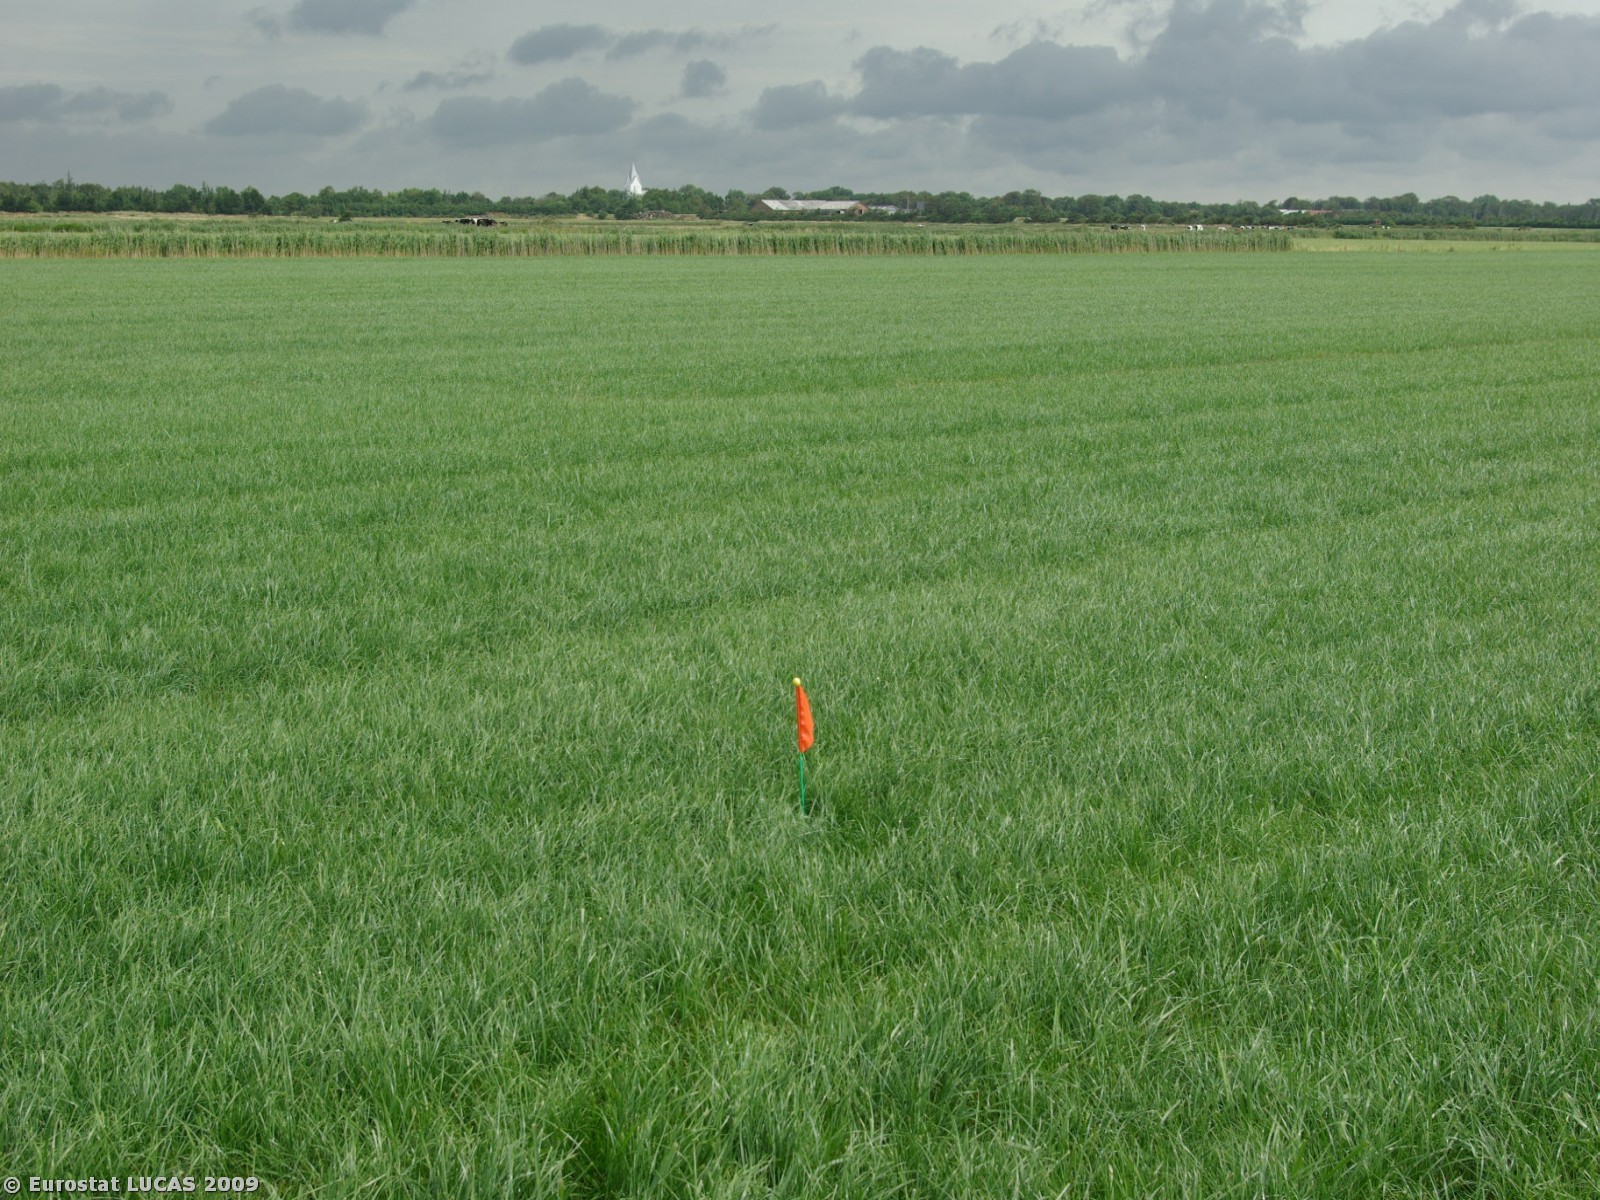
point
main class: Cropland
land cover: Temporary grasslands
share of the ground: > 75 %
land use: Agriculture (excluding fallow land and kitchen gardens)
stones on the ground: < 10 %
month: July
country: DK
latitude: 55.2819
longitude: 8.6629
